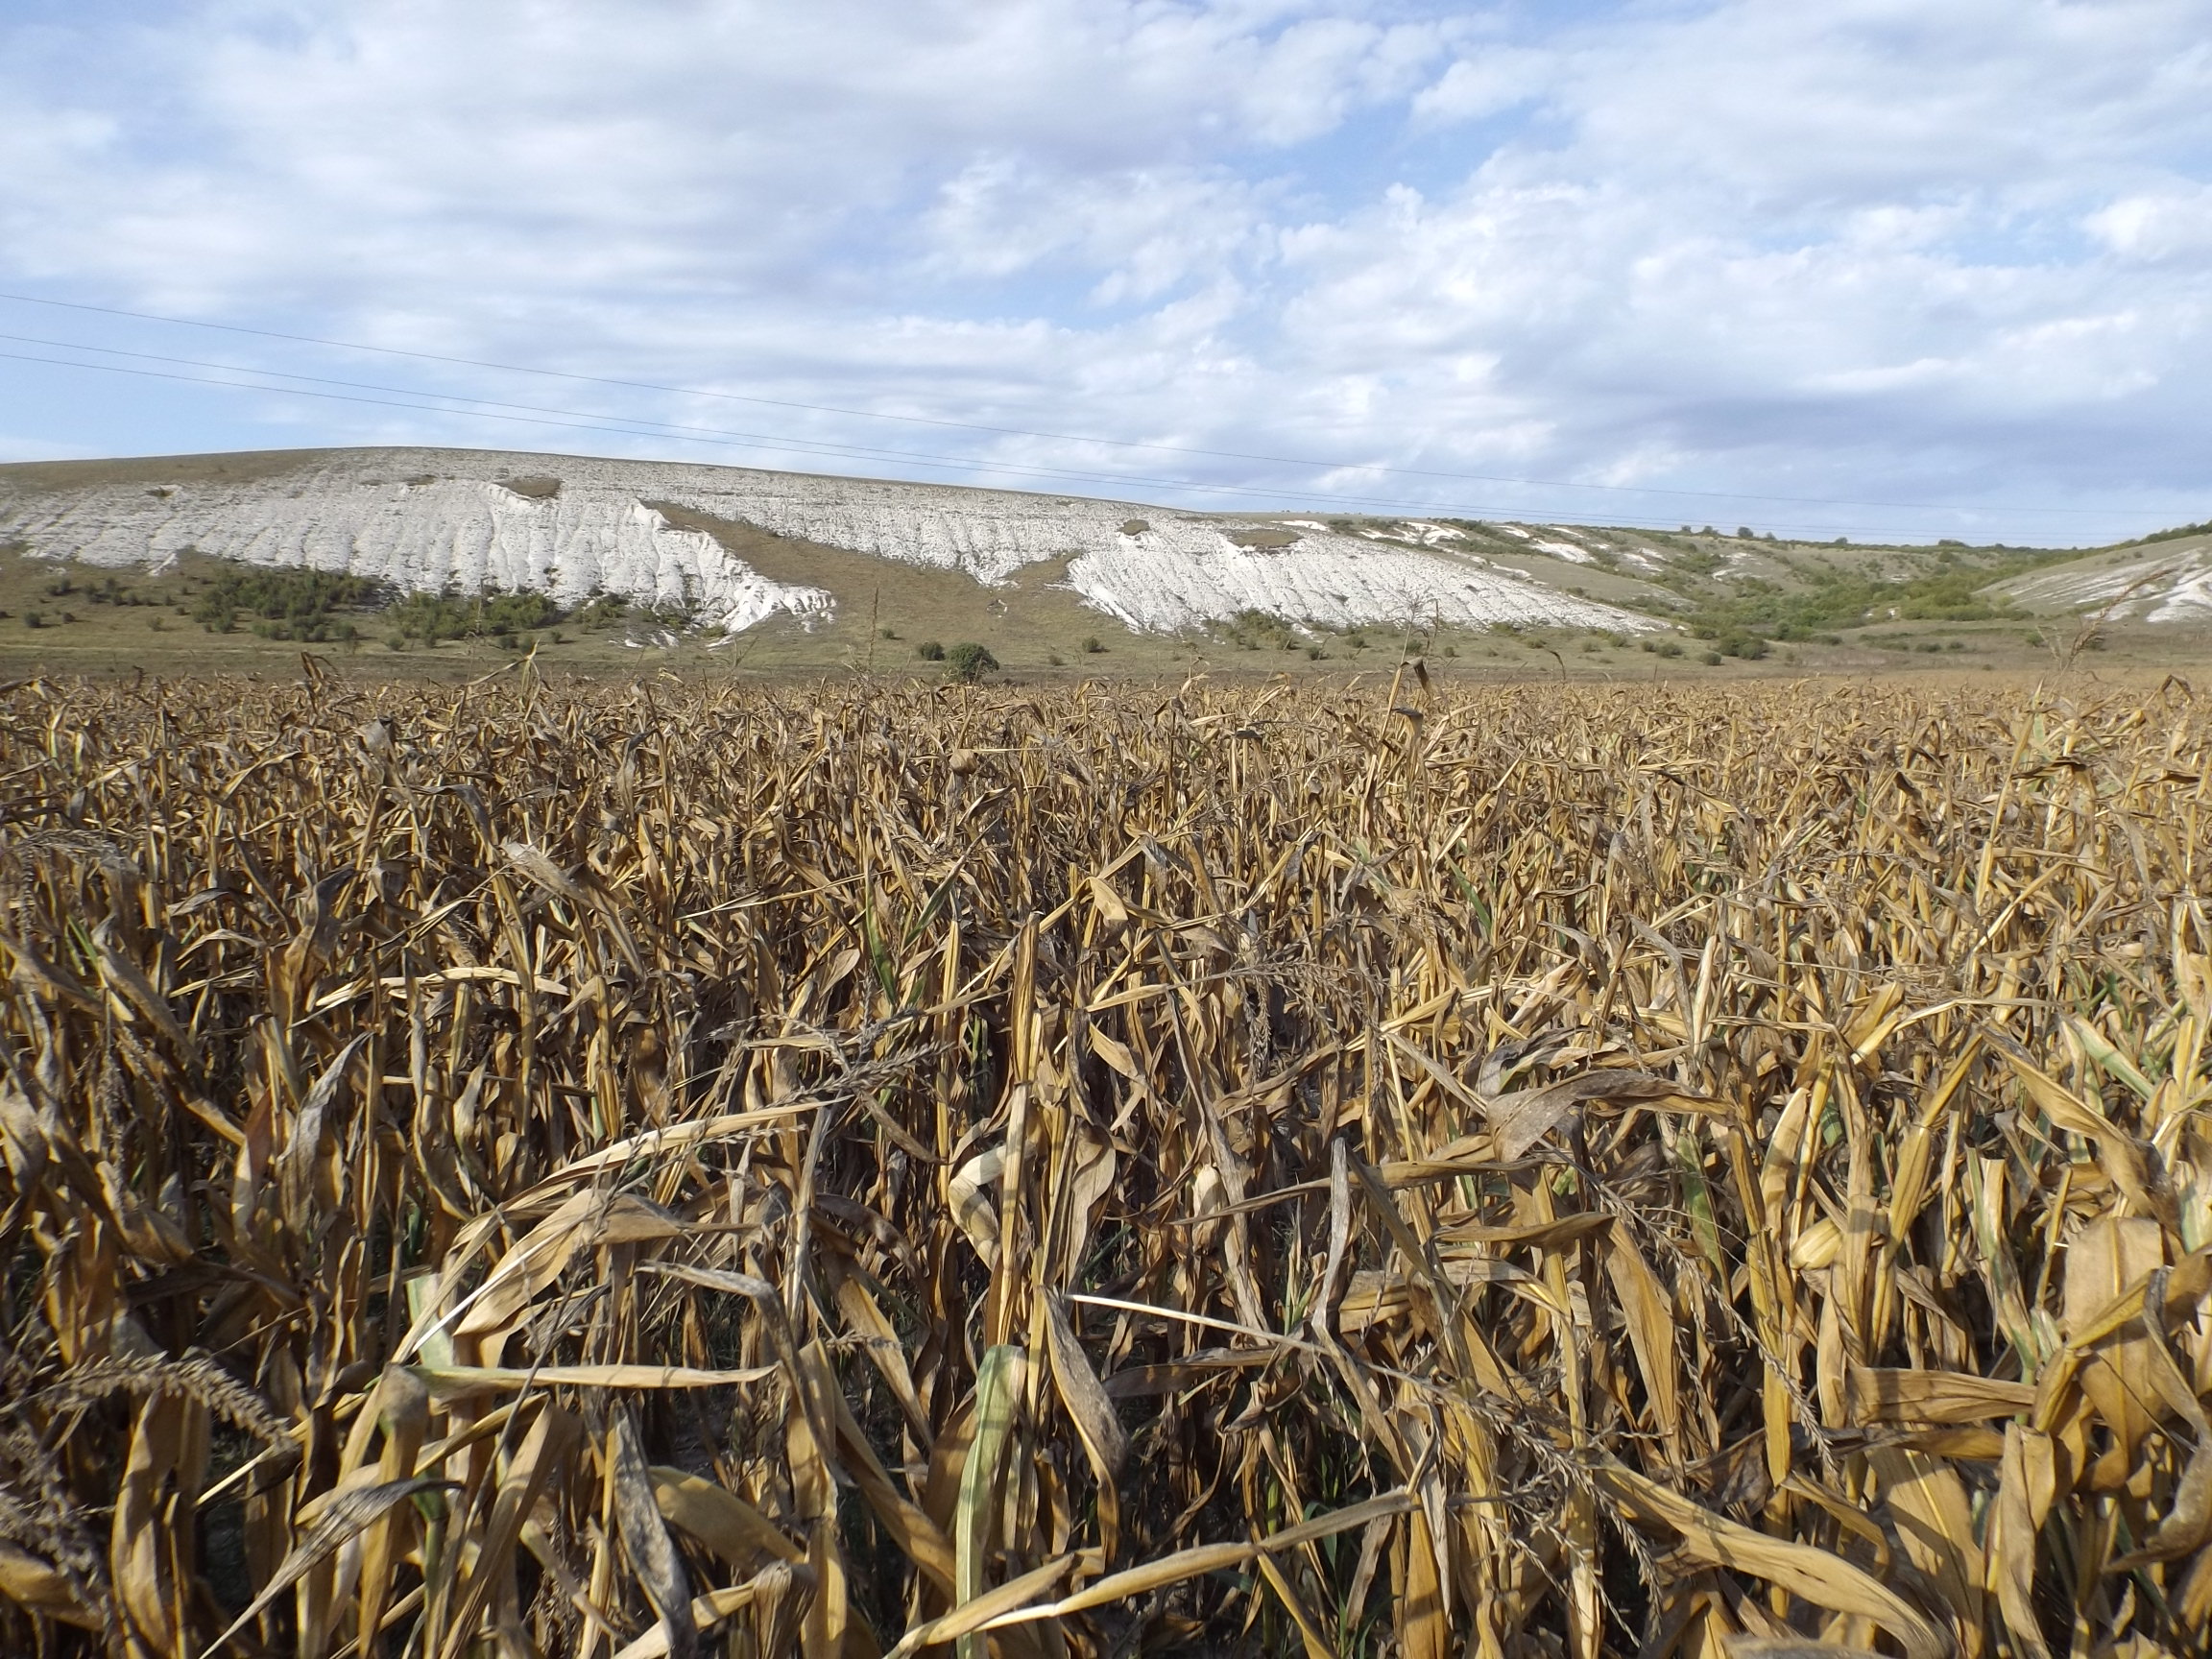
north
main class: Cropland
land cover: Maize
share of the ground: > 75 %
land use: Agriculture (excluding fallow land and kitchen gardens)
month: September
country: BG
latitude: 43.2514
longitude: 27.3048
